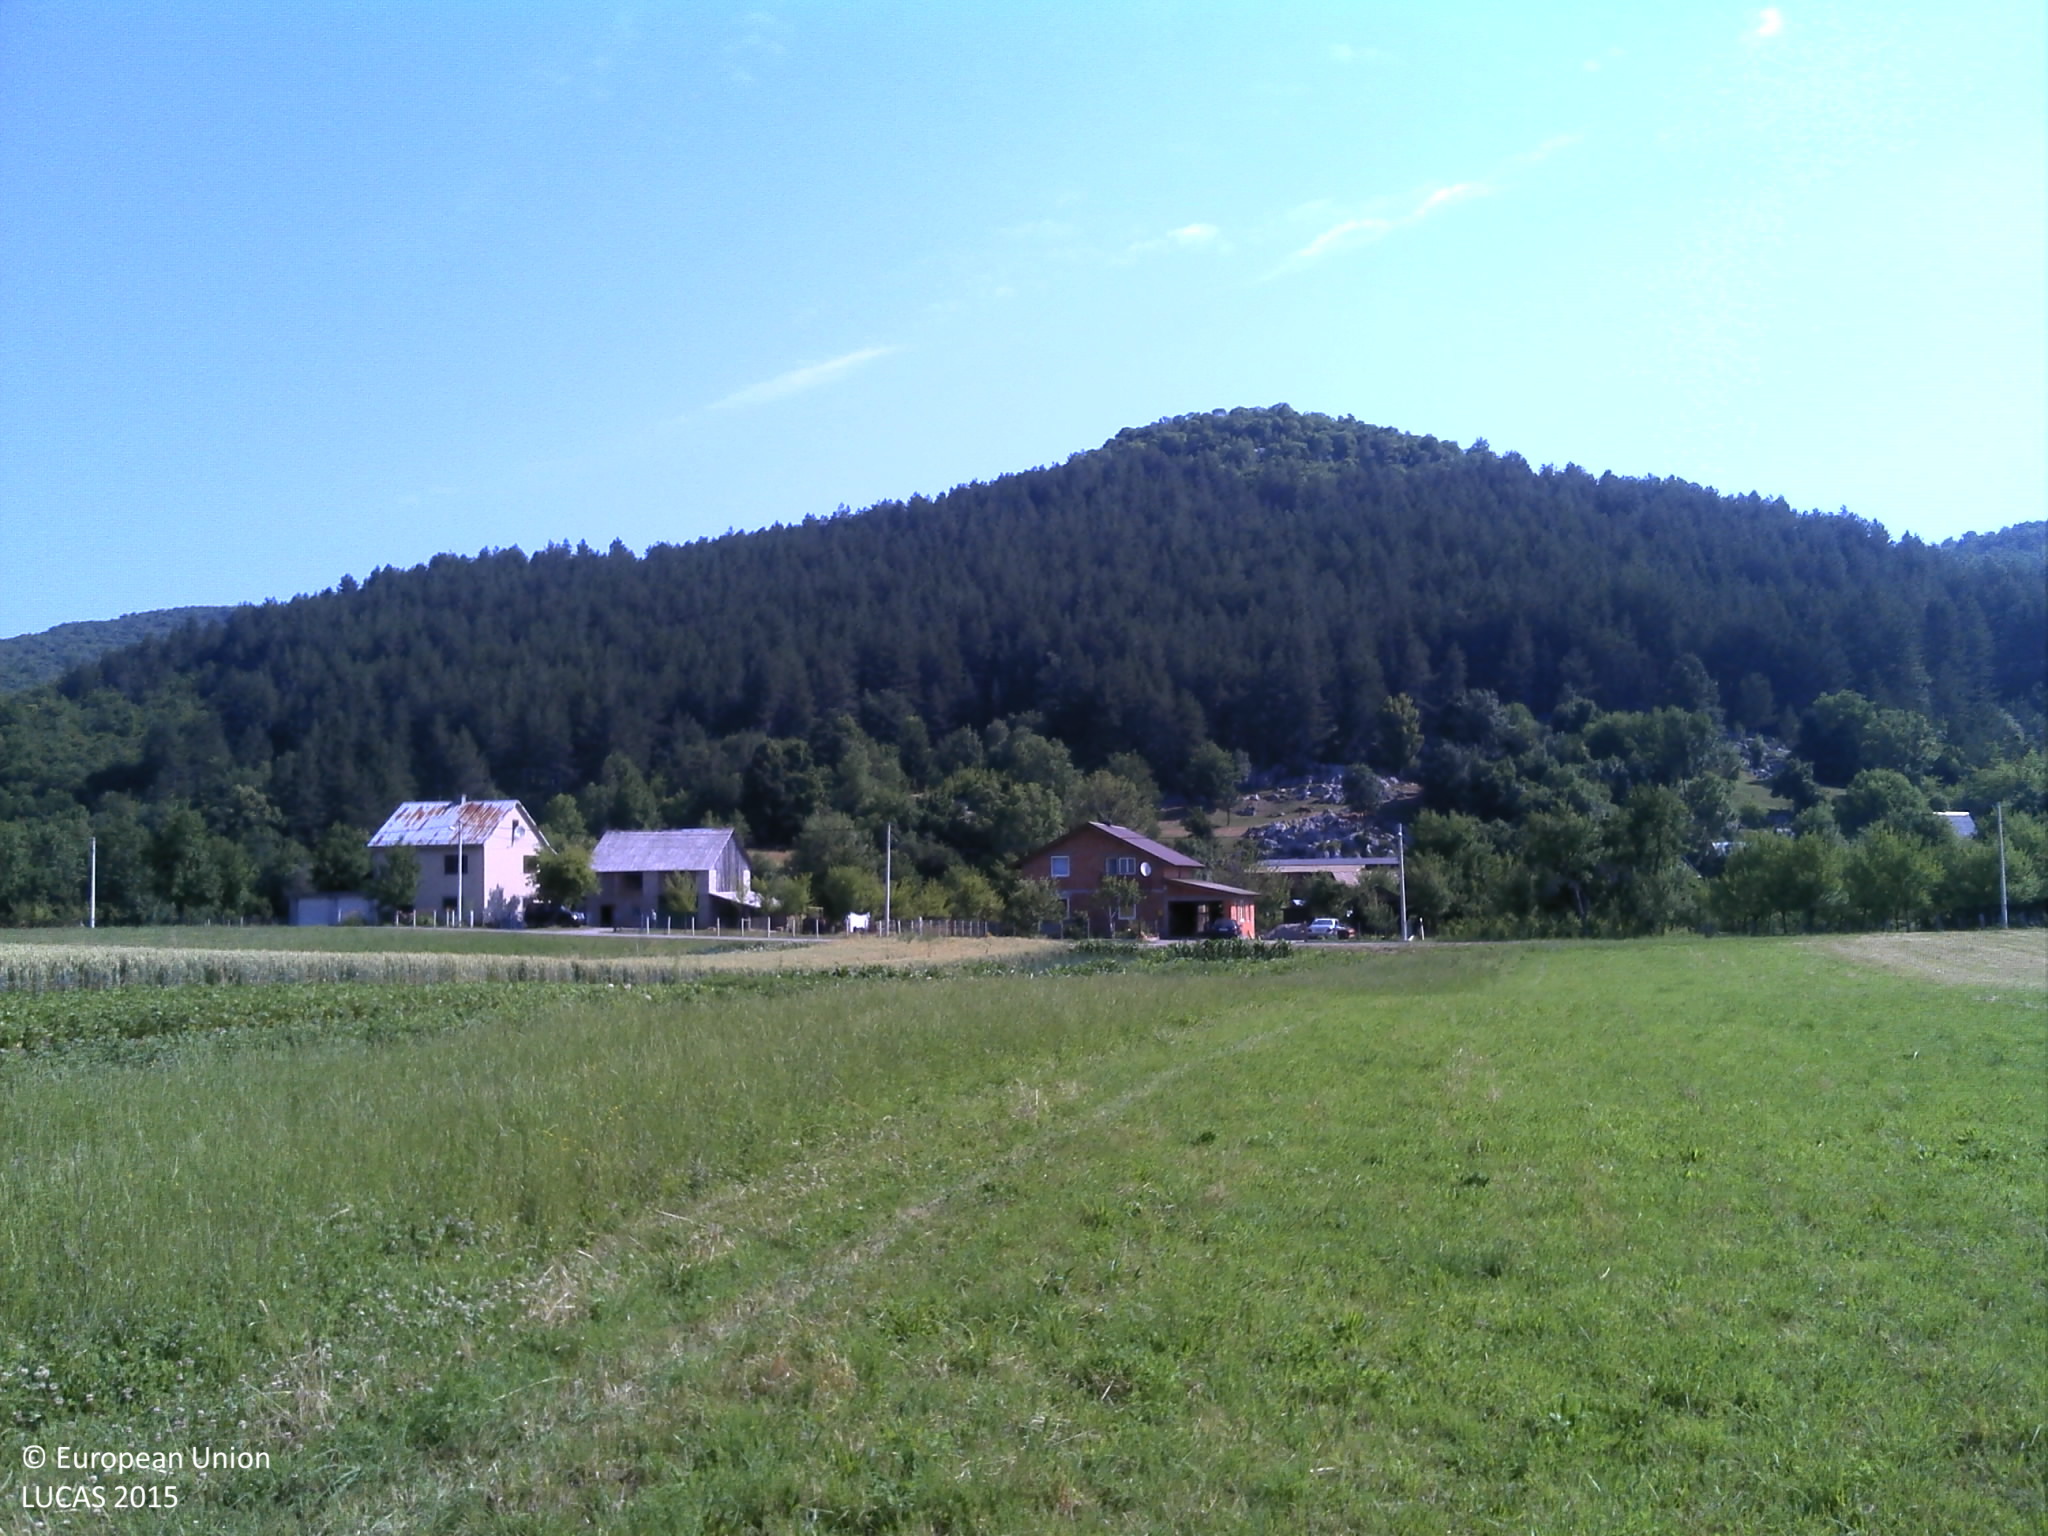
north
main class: Grassland
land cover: Grassland without tree/shrub cover
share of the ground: > 75 %
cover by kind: herbaceous plants 100 %
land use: Agriculture (excluding fallow land and kitchen gardens)
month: July
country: HR
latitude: 44.6538
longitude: 15.2015
